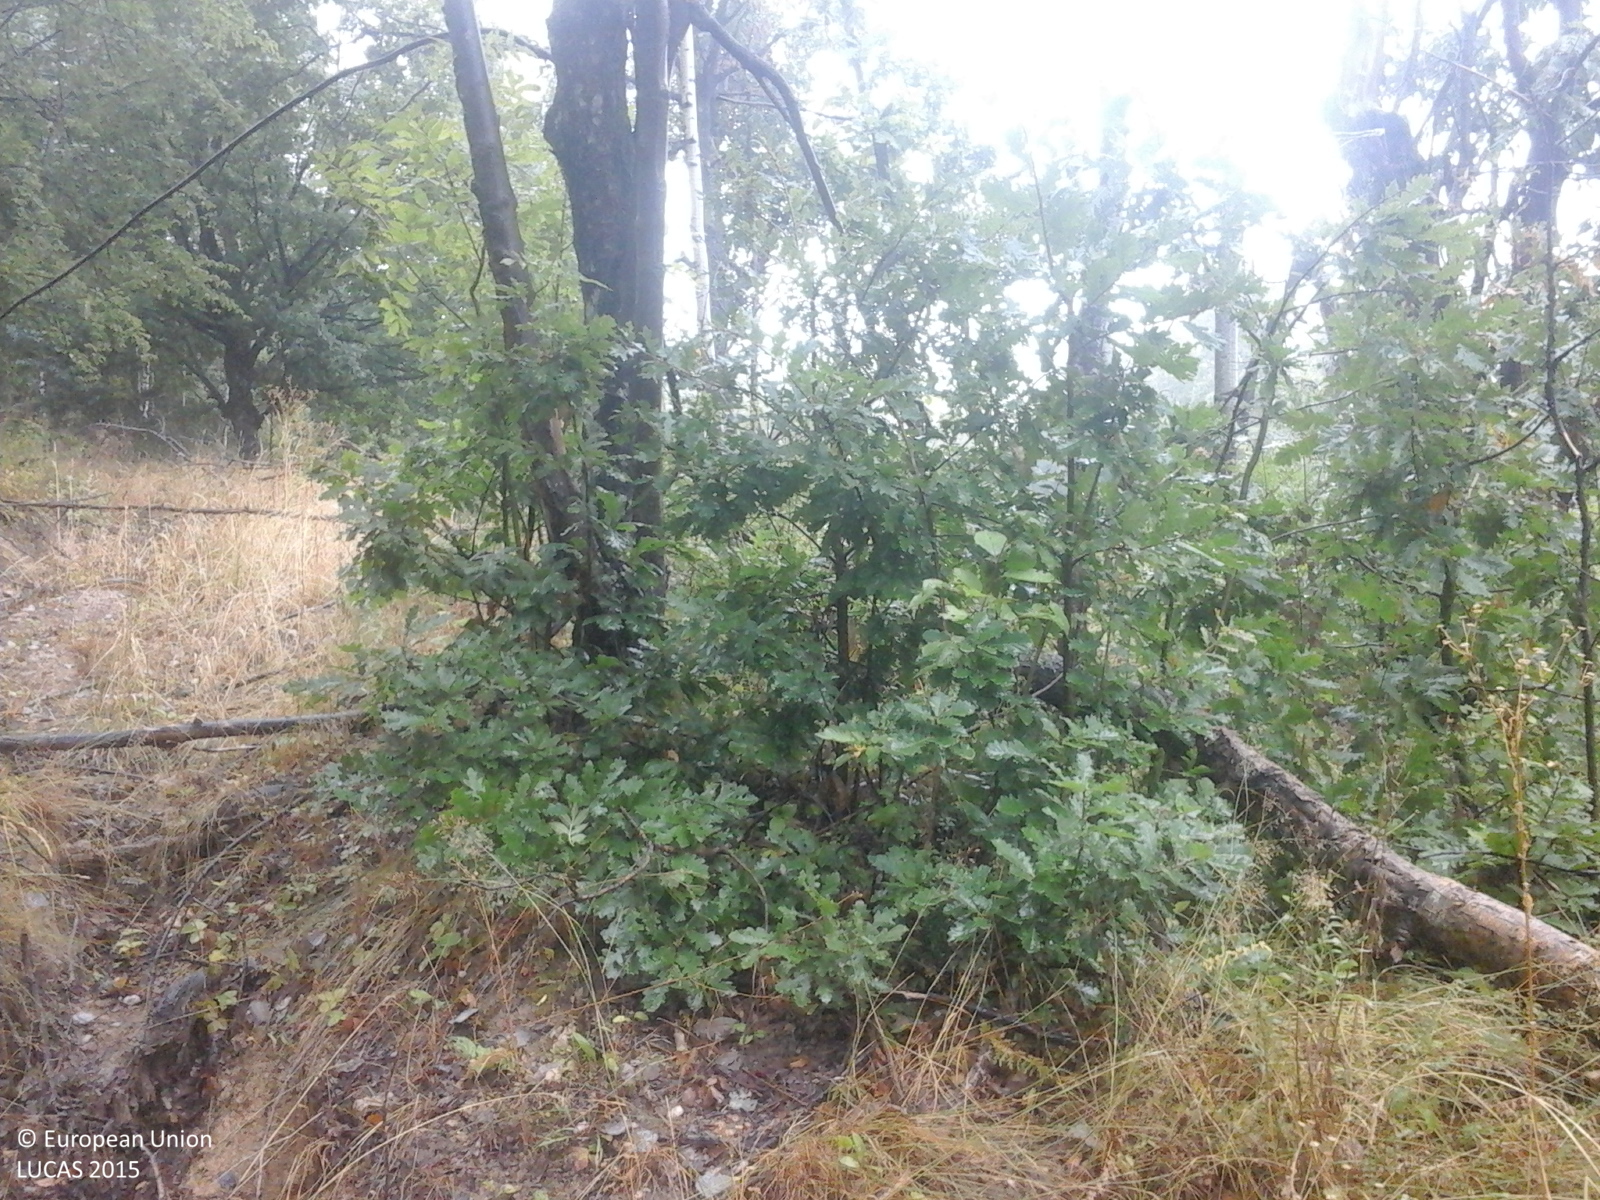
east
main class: Woodland
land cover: Broadleaved woodland
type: acidophilous oak and oak-birch forest
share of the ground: > 75 %
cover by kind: broadleaved forest trees 100 %
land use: Forestry
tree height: > 5 m
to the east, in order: Broadleaved woodland
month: August
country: RO
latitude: 44.9614
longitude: 22.1694
